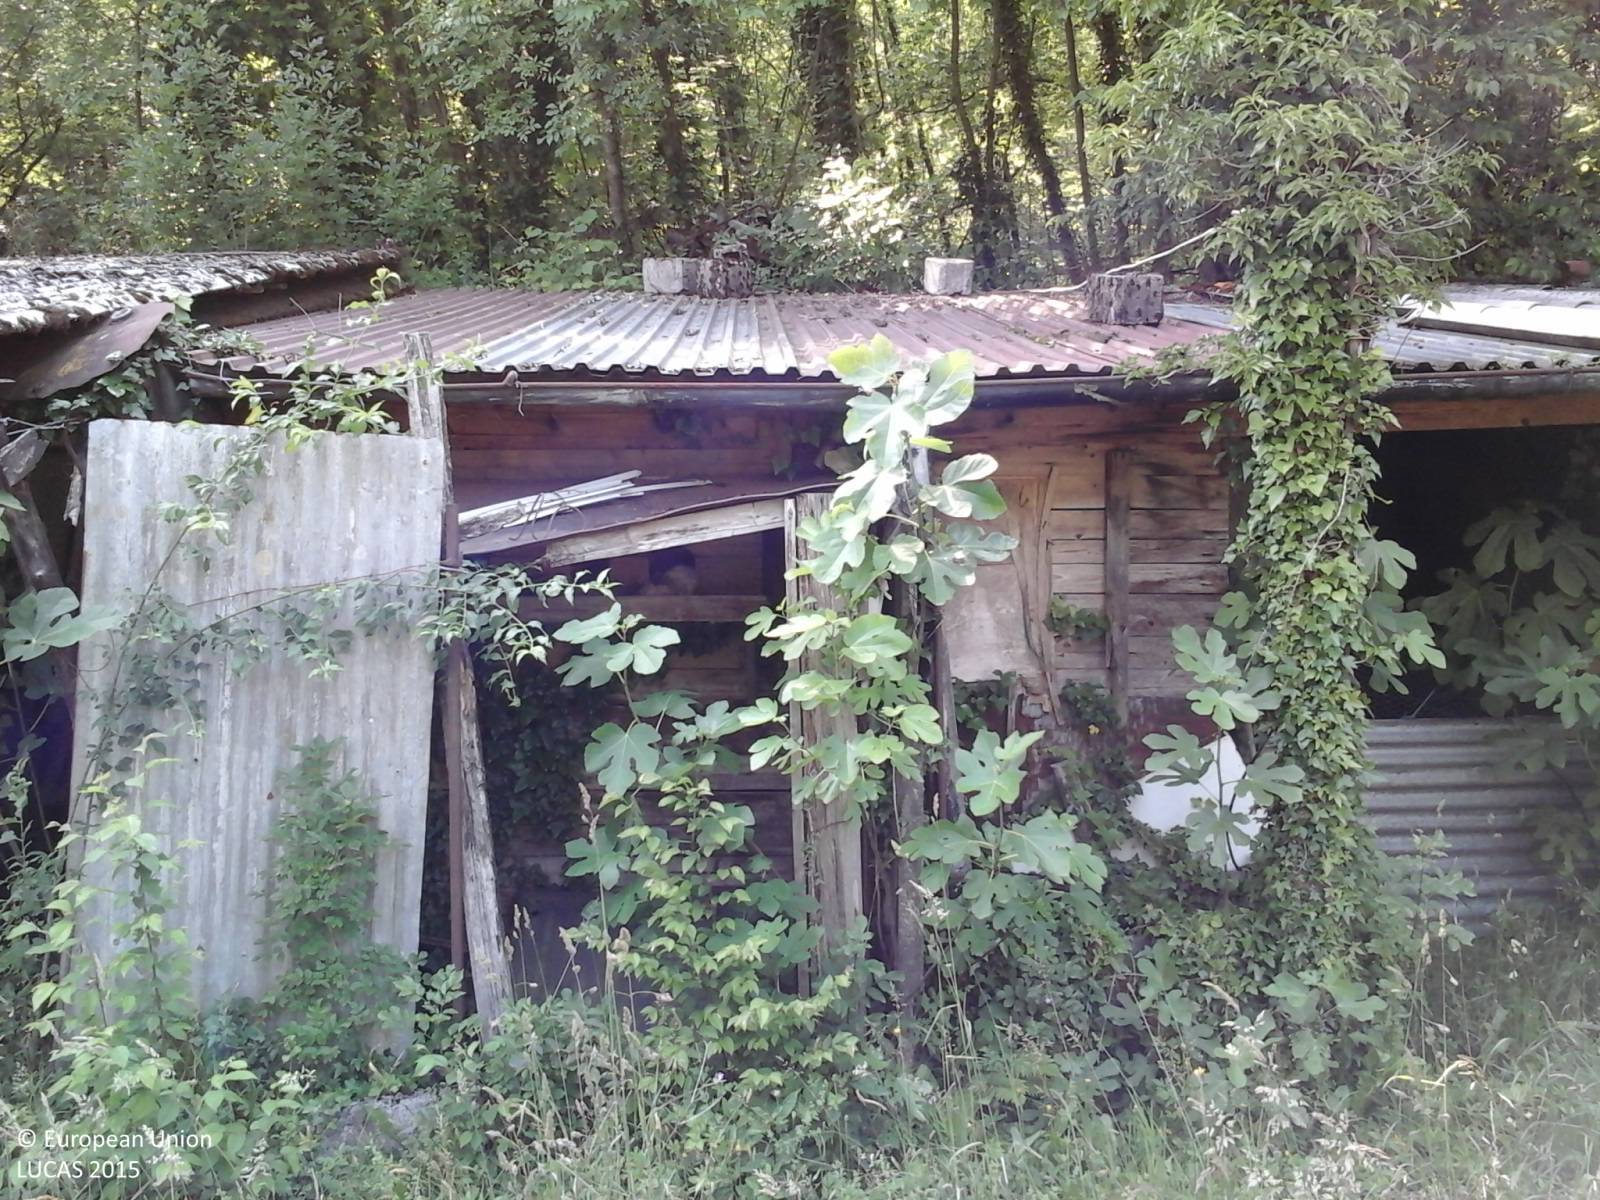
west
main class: Grassland
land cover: Grassland without tree/shrub cover
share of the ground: > 75 %
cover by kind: herbaceous plants 100 %
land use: Agriculture (excluding fallow land and kitchen gardens)
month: June
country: IT
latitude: 46.3078
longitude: 13.0482
